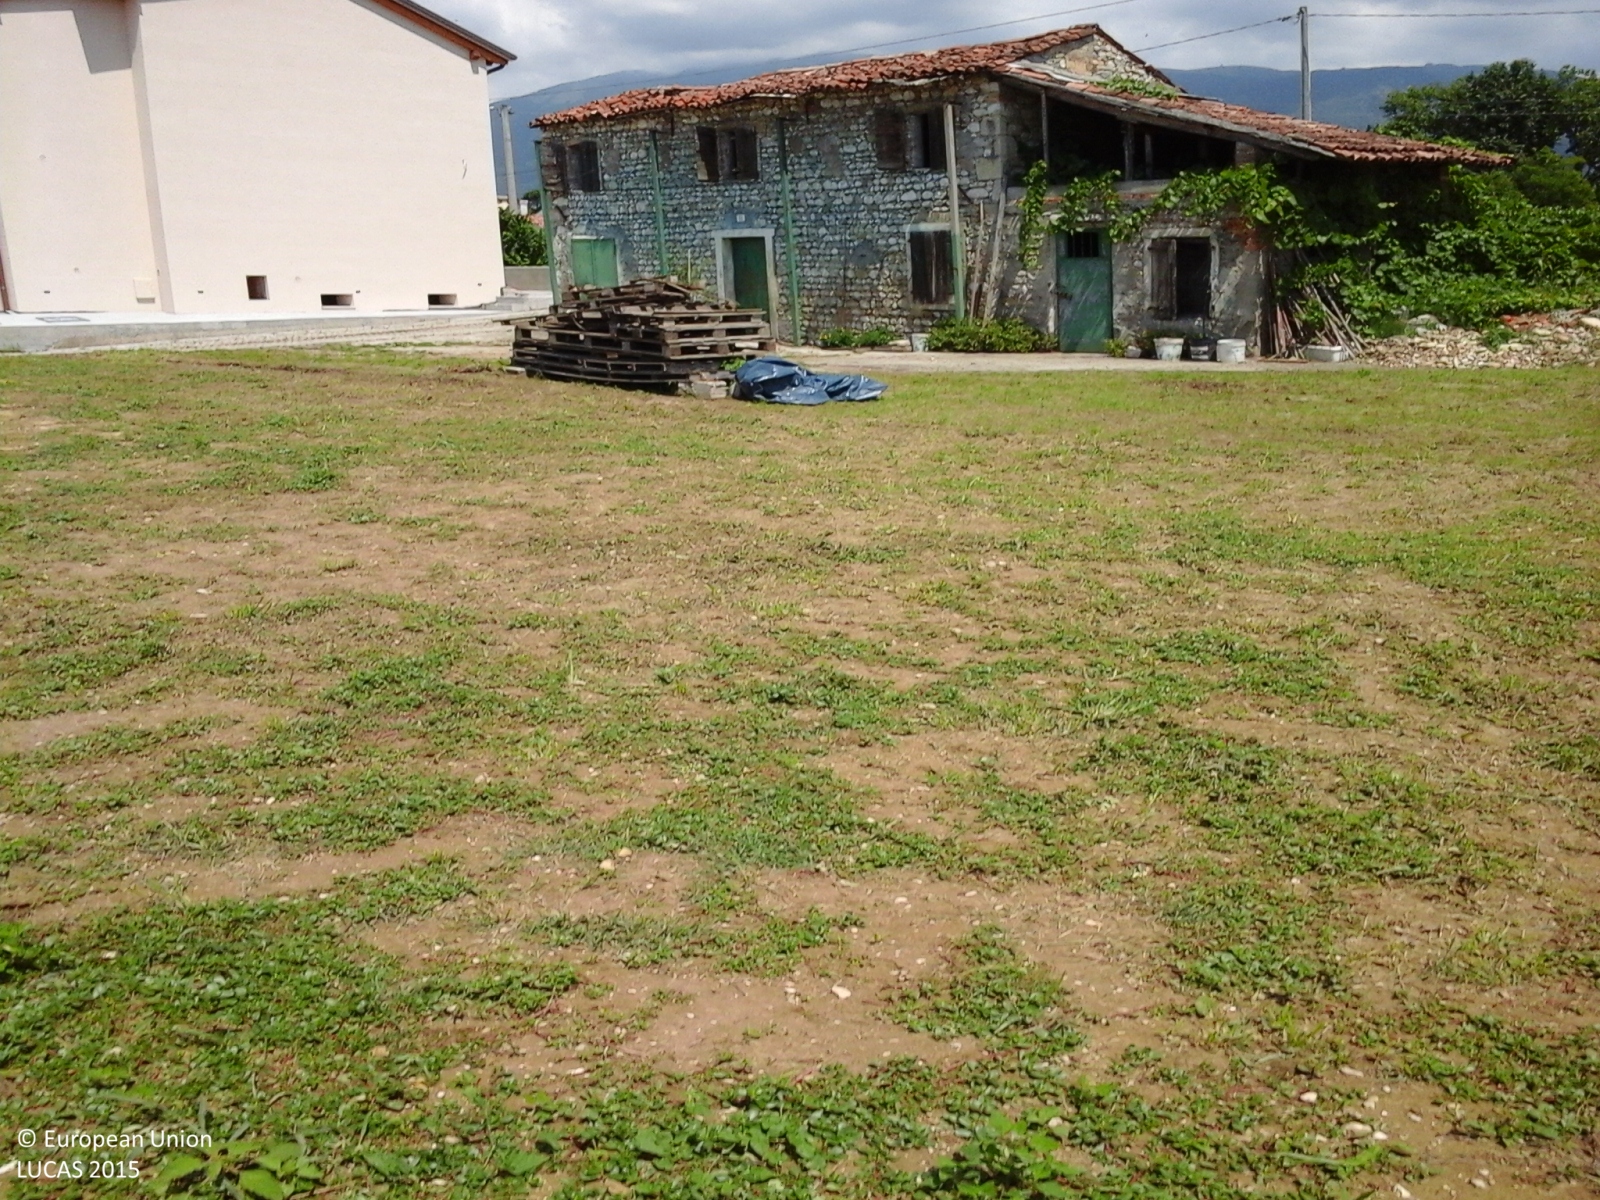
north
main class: Grassland
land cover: Spontaneously vegetated surfaces
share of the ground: > 75 %
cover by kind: herbaceous plants 50 %, consolidated bare surface 50 %
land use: Fallow land
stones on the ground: 10 - 25 %
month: June
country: IT
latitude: 45.9648
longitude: 12.3584
